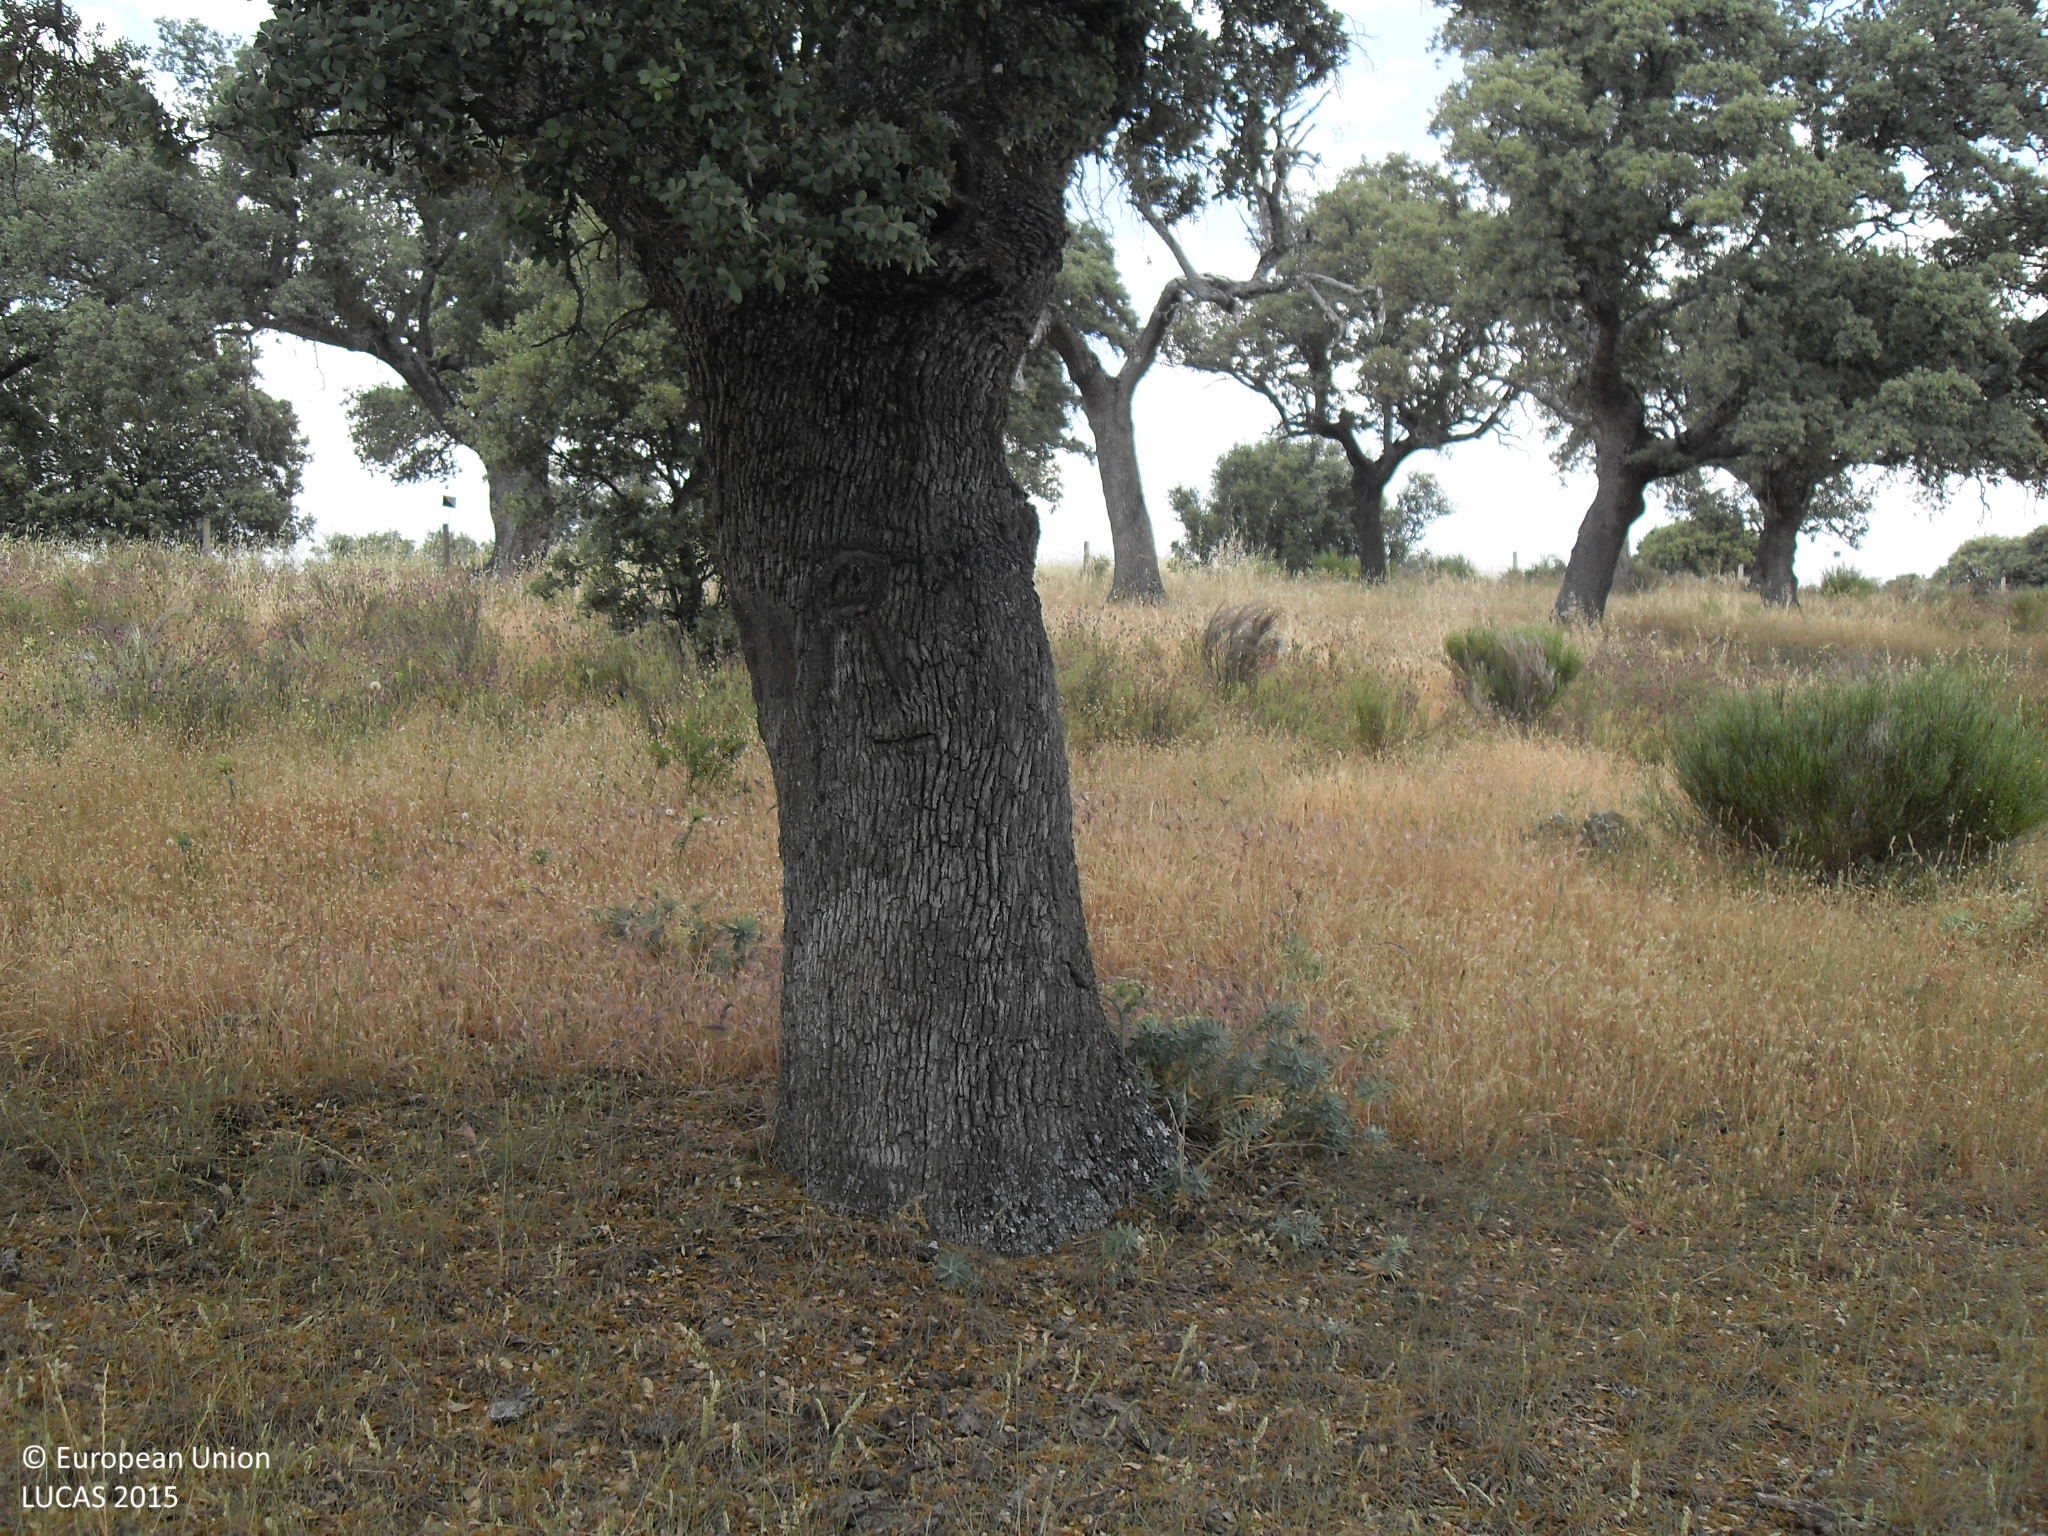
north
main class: Woodland
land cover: Broadleaved woodland
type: broadleaved evergreen forest
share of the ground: 25 - 50 %
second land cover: Grassland without tree/shrub cover
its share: 50 - 75 %
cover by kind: herbaceous plants 65 %, broadleaved forest trees 35 %
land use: Forestry
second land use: Agriculture (excluding fallow land and kitchen gardens)
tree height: > 5 m
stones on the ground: < 10 %
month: June
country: ES
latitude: 40.5095
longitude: -5.5399
